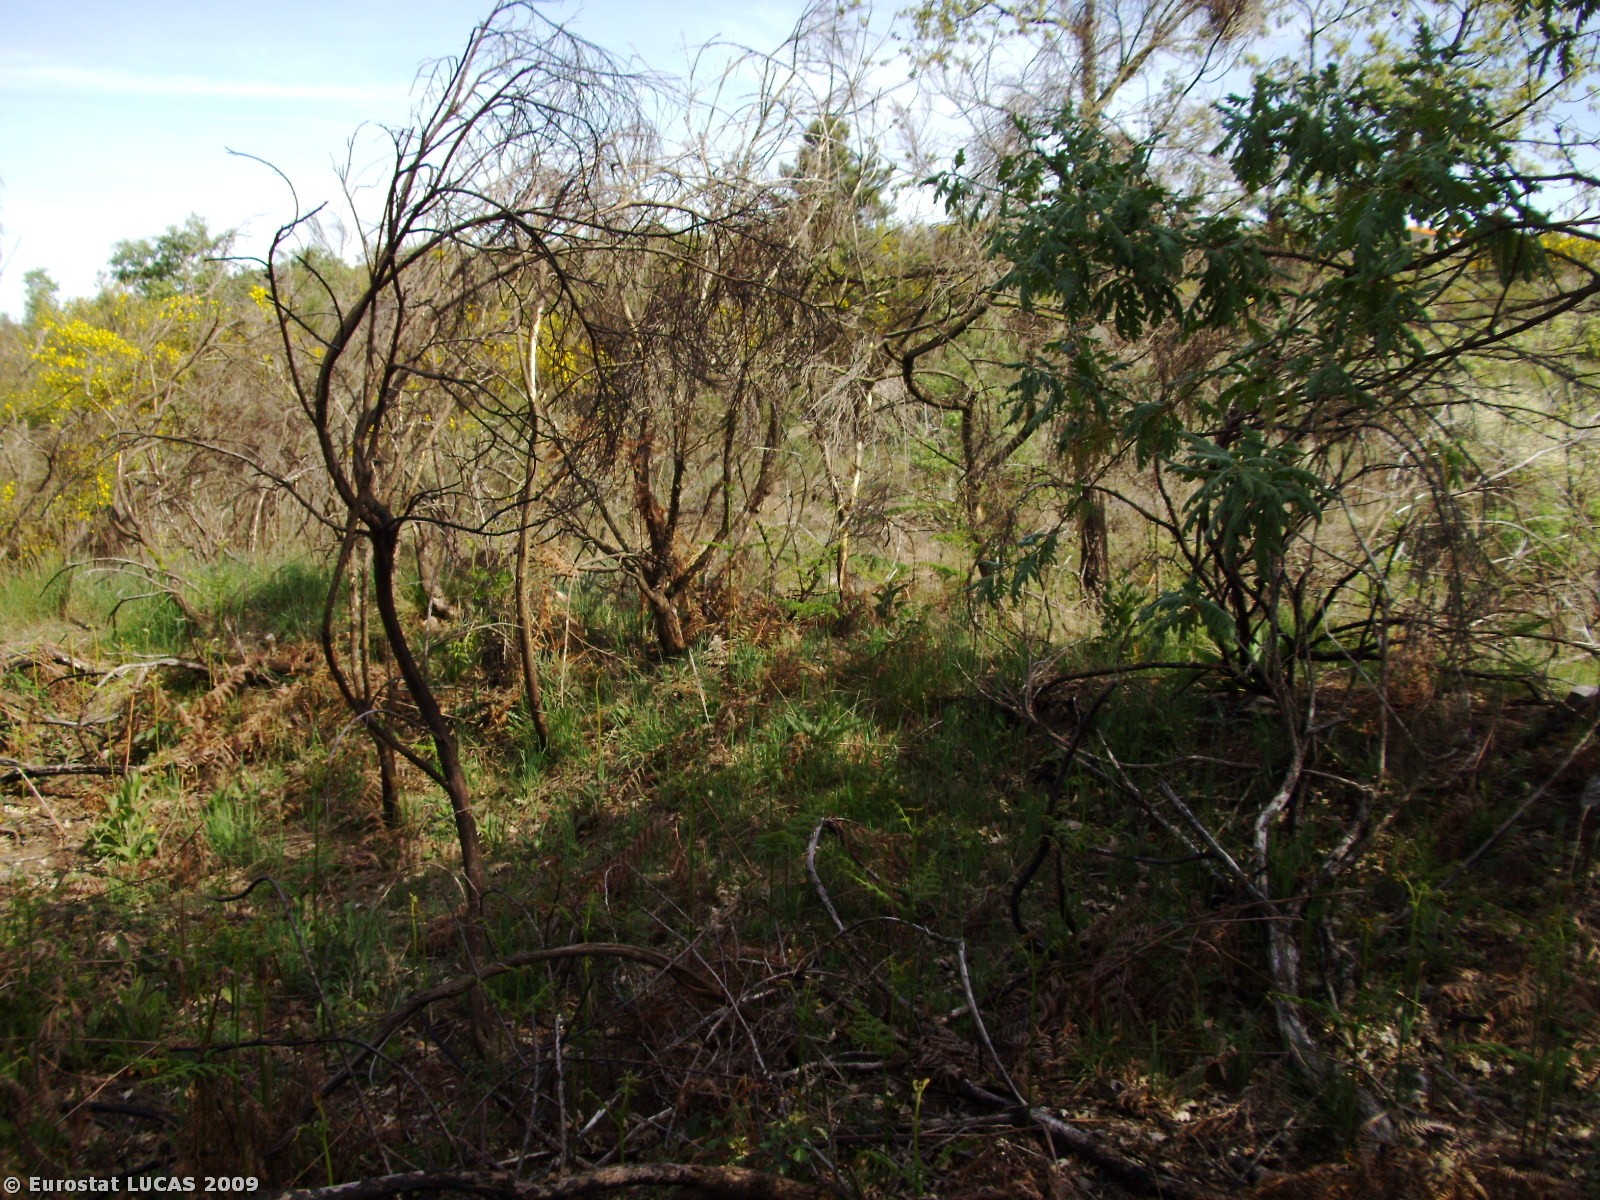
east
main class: Woodland
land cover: Broadleaved woodland
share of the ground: > 75 %
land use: Forestry
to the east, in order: Broadleaved woodland; Shrubland with sparse tree cover; Dry stone walls; Bare land; Shrubland with sparse tree cover; Tracks; Shrubland with sparse tree cover; Tracks; Coniferous woodland
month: May
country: PT
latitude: 40.9756
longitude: -7.3591
